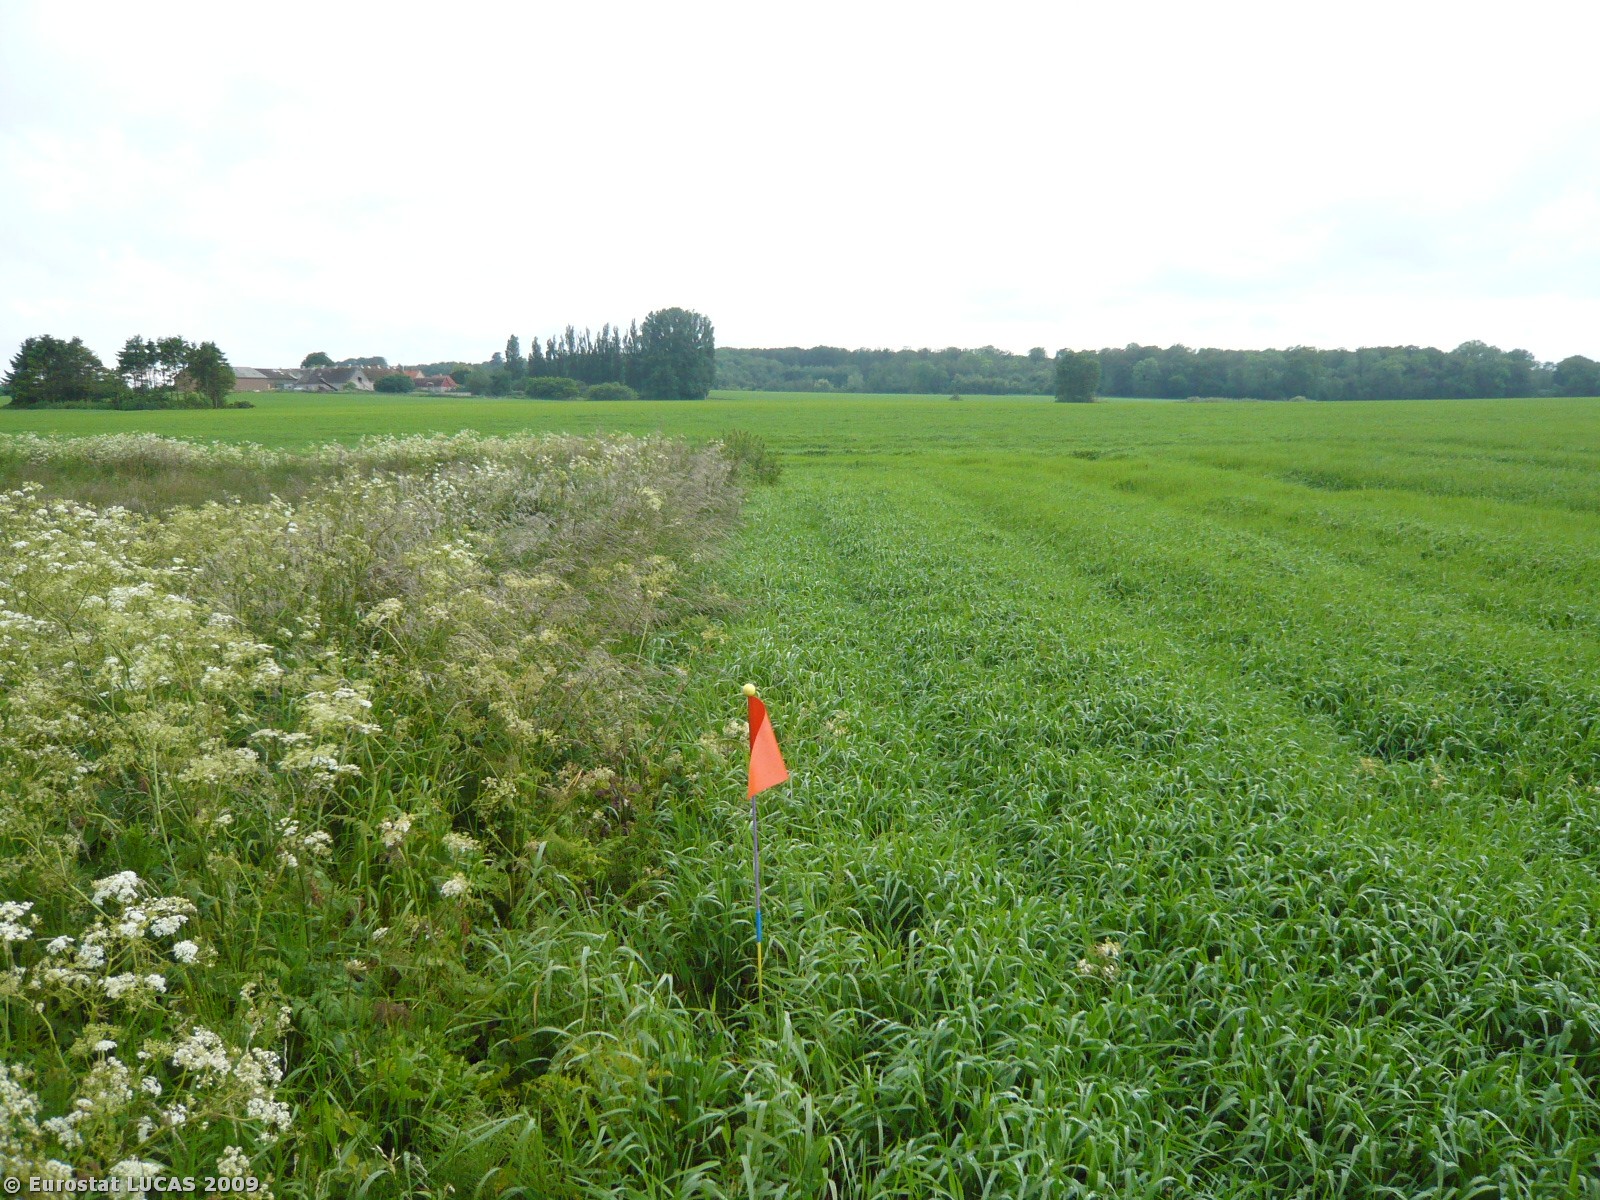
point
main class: Cropland
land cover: Barley
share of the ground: > 75 %
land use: Agriculture (excluding fallow land and kitchen gardens)
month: June
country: DK
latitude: 54.9149
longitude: 11.9175
